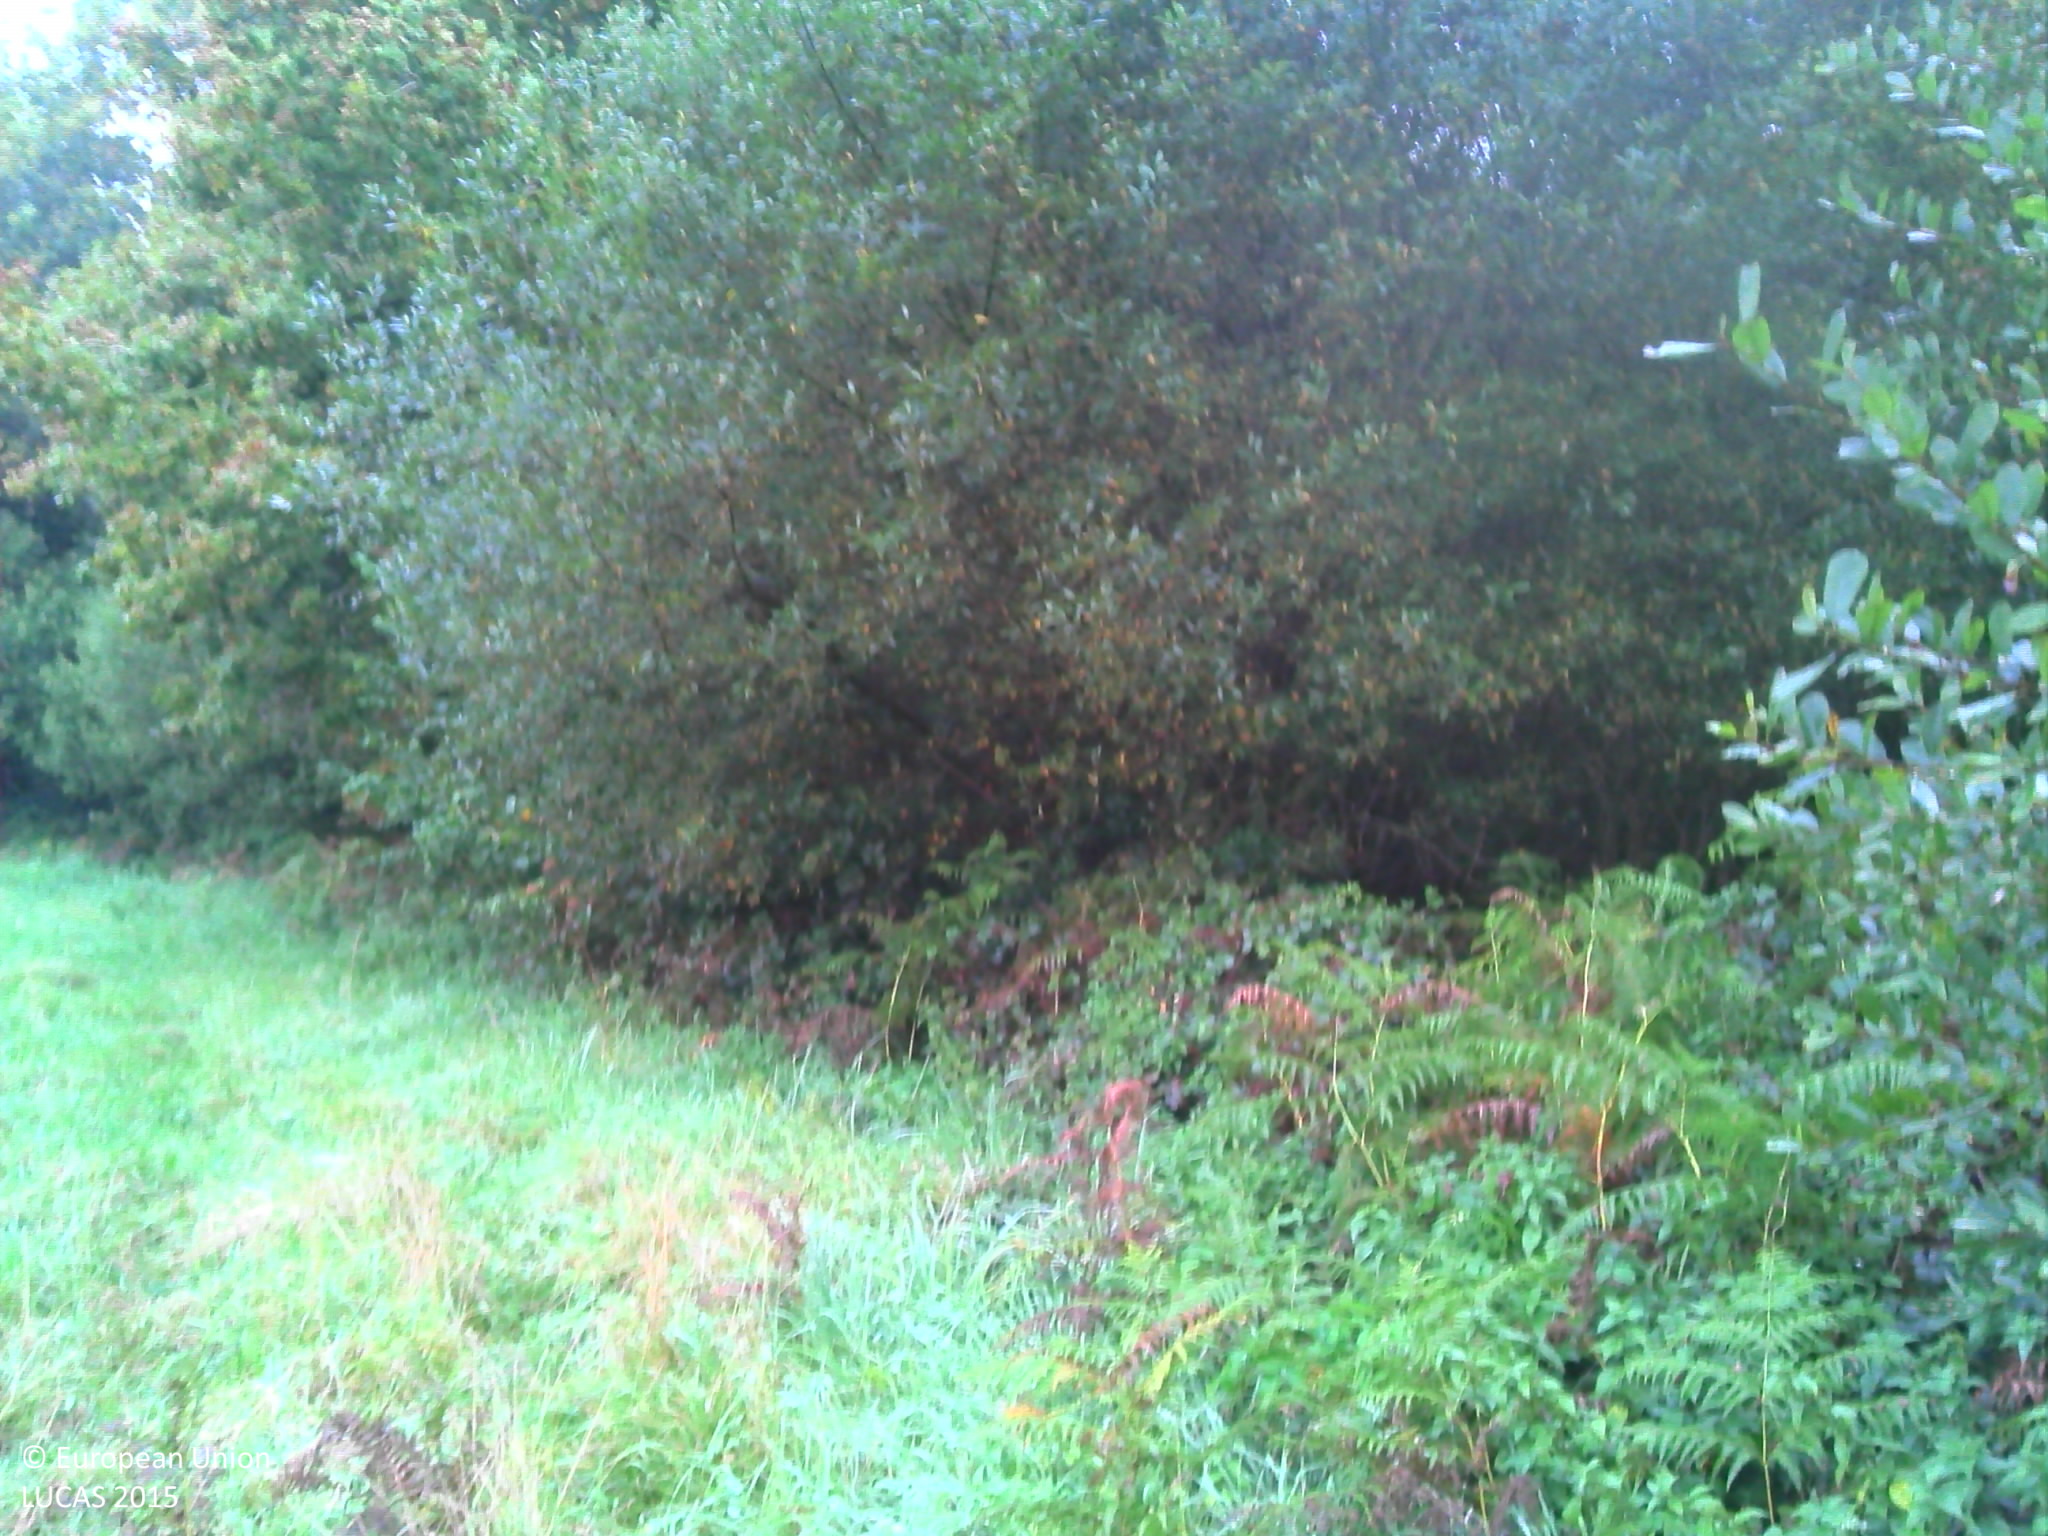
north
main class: Grassland
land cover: Spontaneously vegetated surfaces
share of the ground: > 75 %
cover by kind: herbaceous plants 95 %, shrubs 5 %
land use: Semi-natural and natural areas not in use
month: October
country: FR
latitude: 47.6600
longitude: -2.2917
